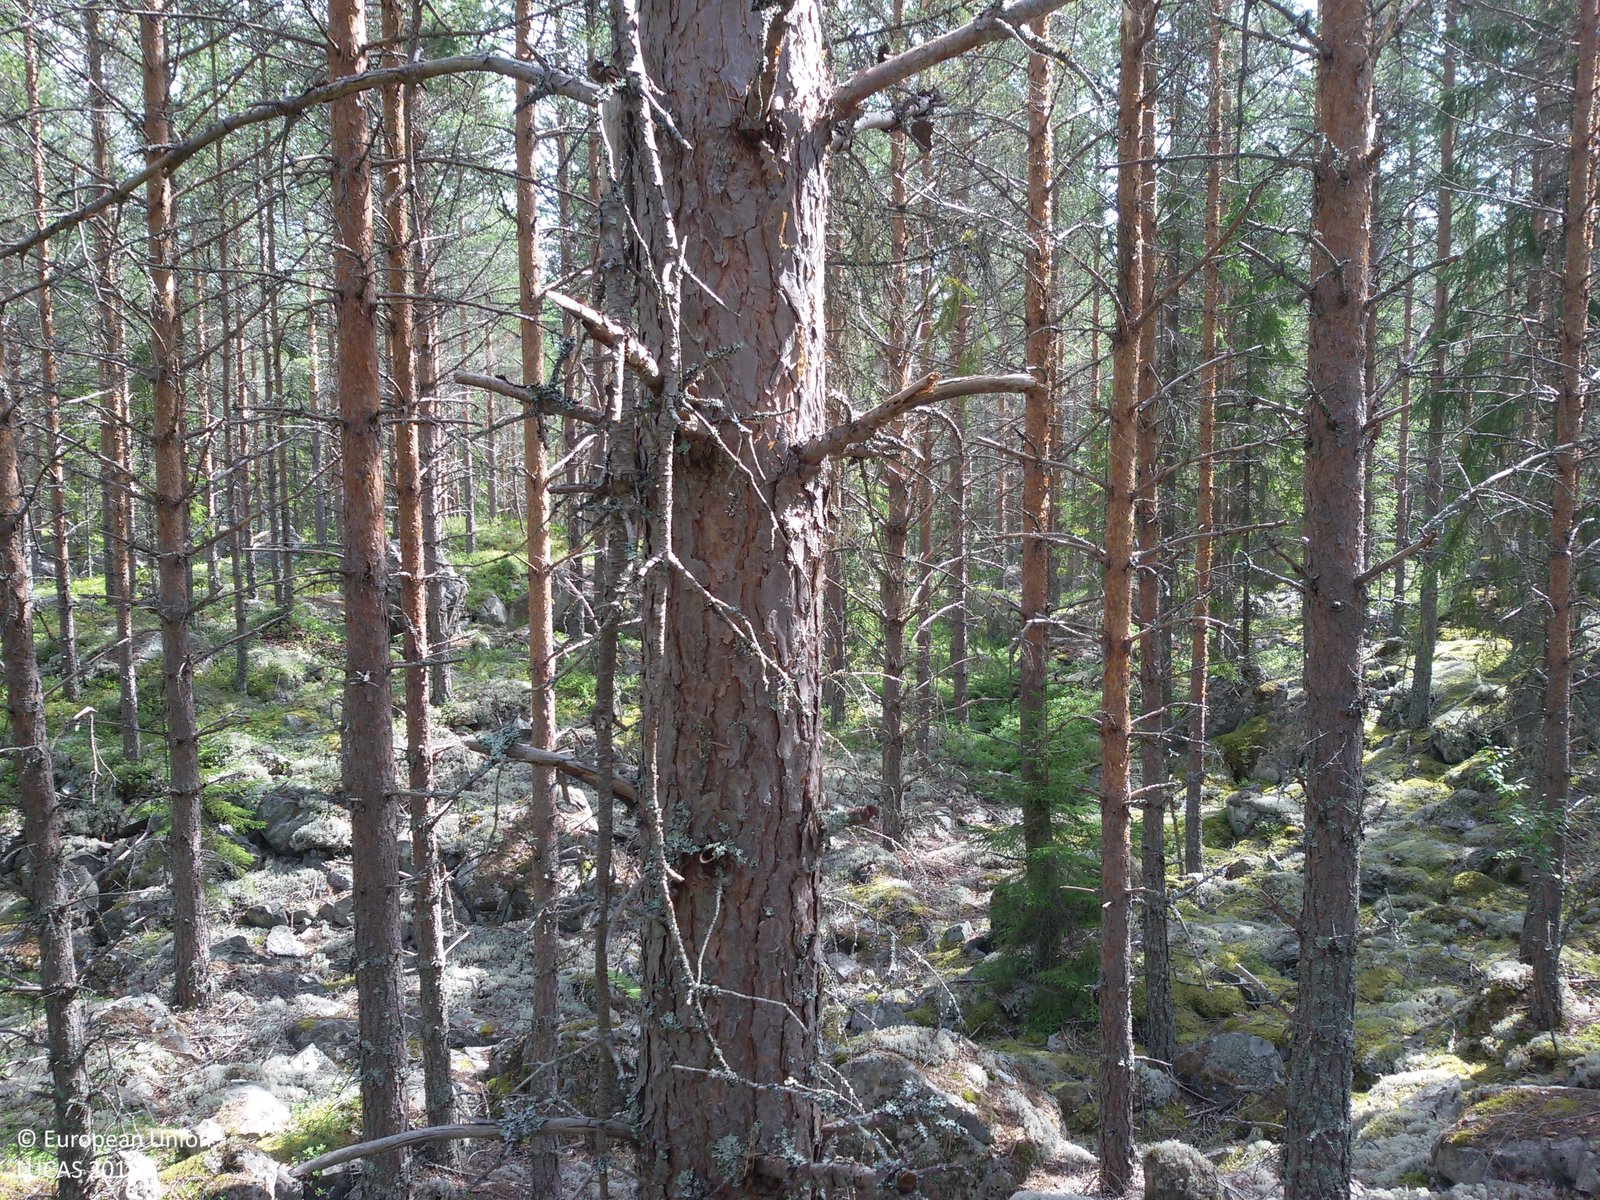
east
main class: Woodland
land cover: Pine dominated coniferous woodland
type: boreal forest
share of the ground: > 75 %
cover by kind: coniferous forest trees 80 %, shrubs 15 %, lichens and mosses 5 %
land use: Forestry
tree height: > 5 m
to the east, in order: Pine dominated coniferous woodland
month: July
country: SE
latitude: 60.6362
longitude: 15.4170
